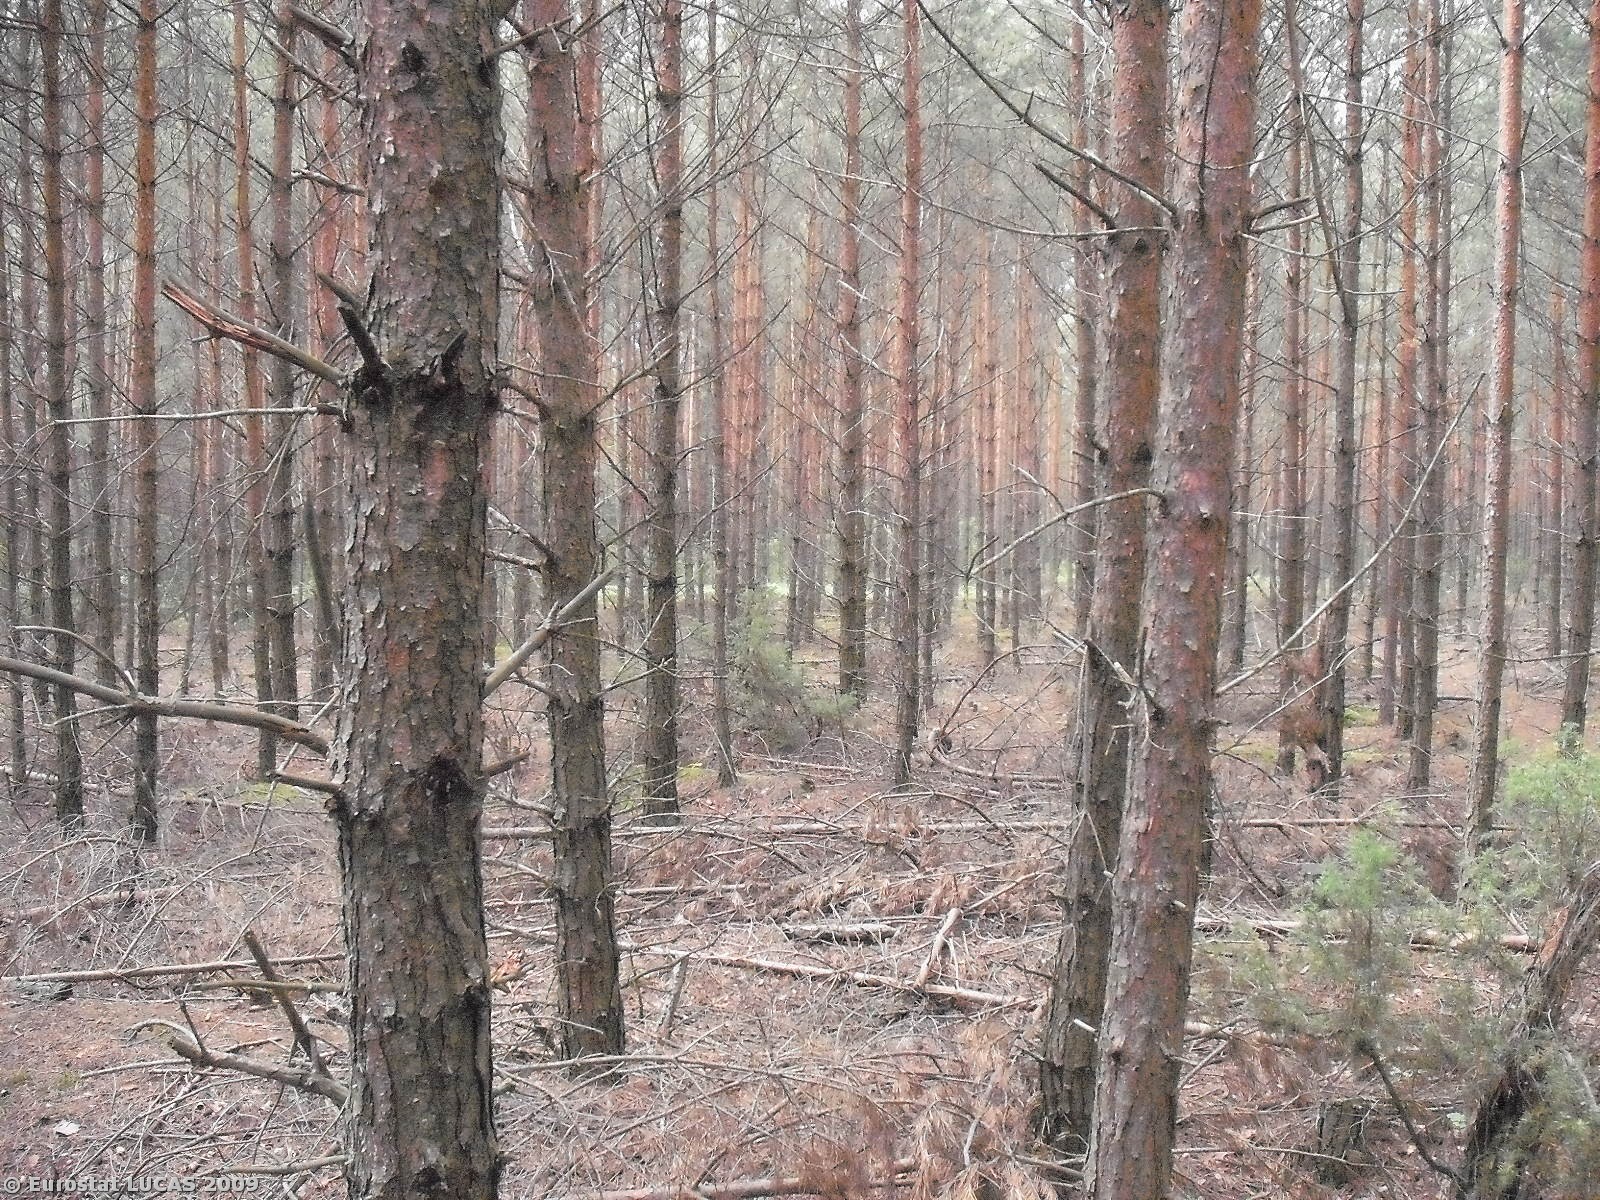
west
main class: Woodland
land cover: Coniferous woodland
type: hemiboreal forest and nemoral coniferous forest and mixed broadleaved-coniferous forest
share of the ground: > 75 %
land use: Forestry
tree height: > 5 m
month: June
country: PL
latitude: 51.2387
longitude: 20.5090
